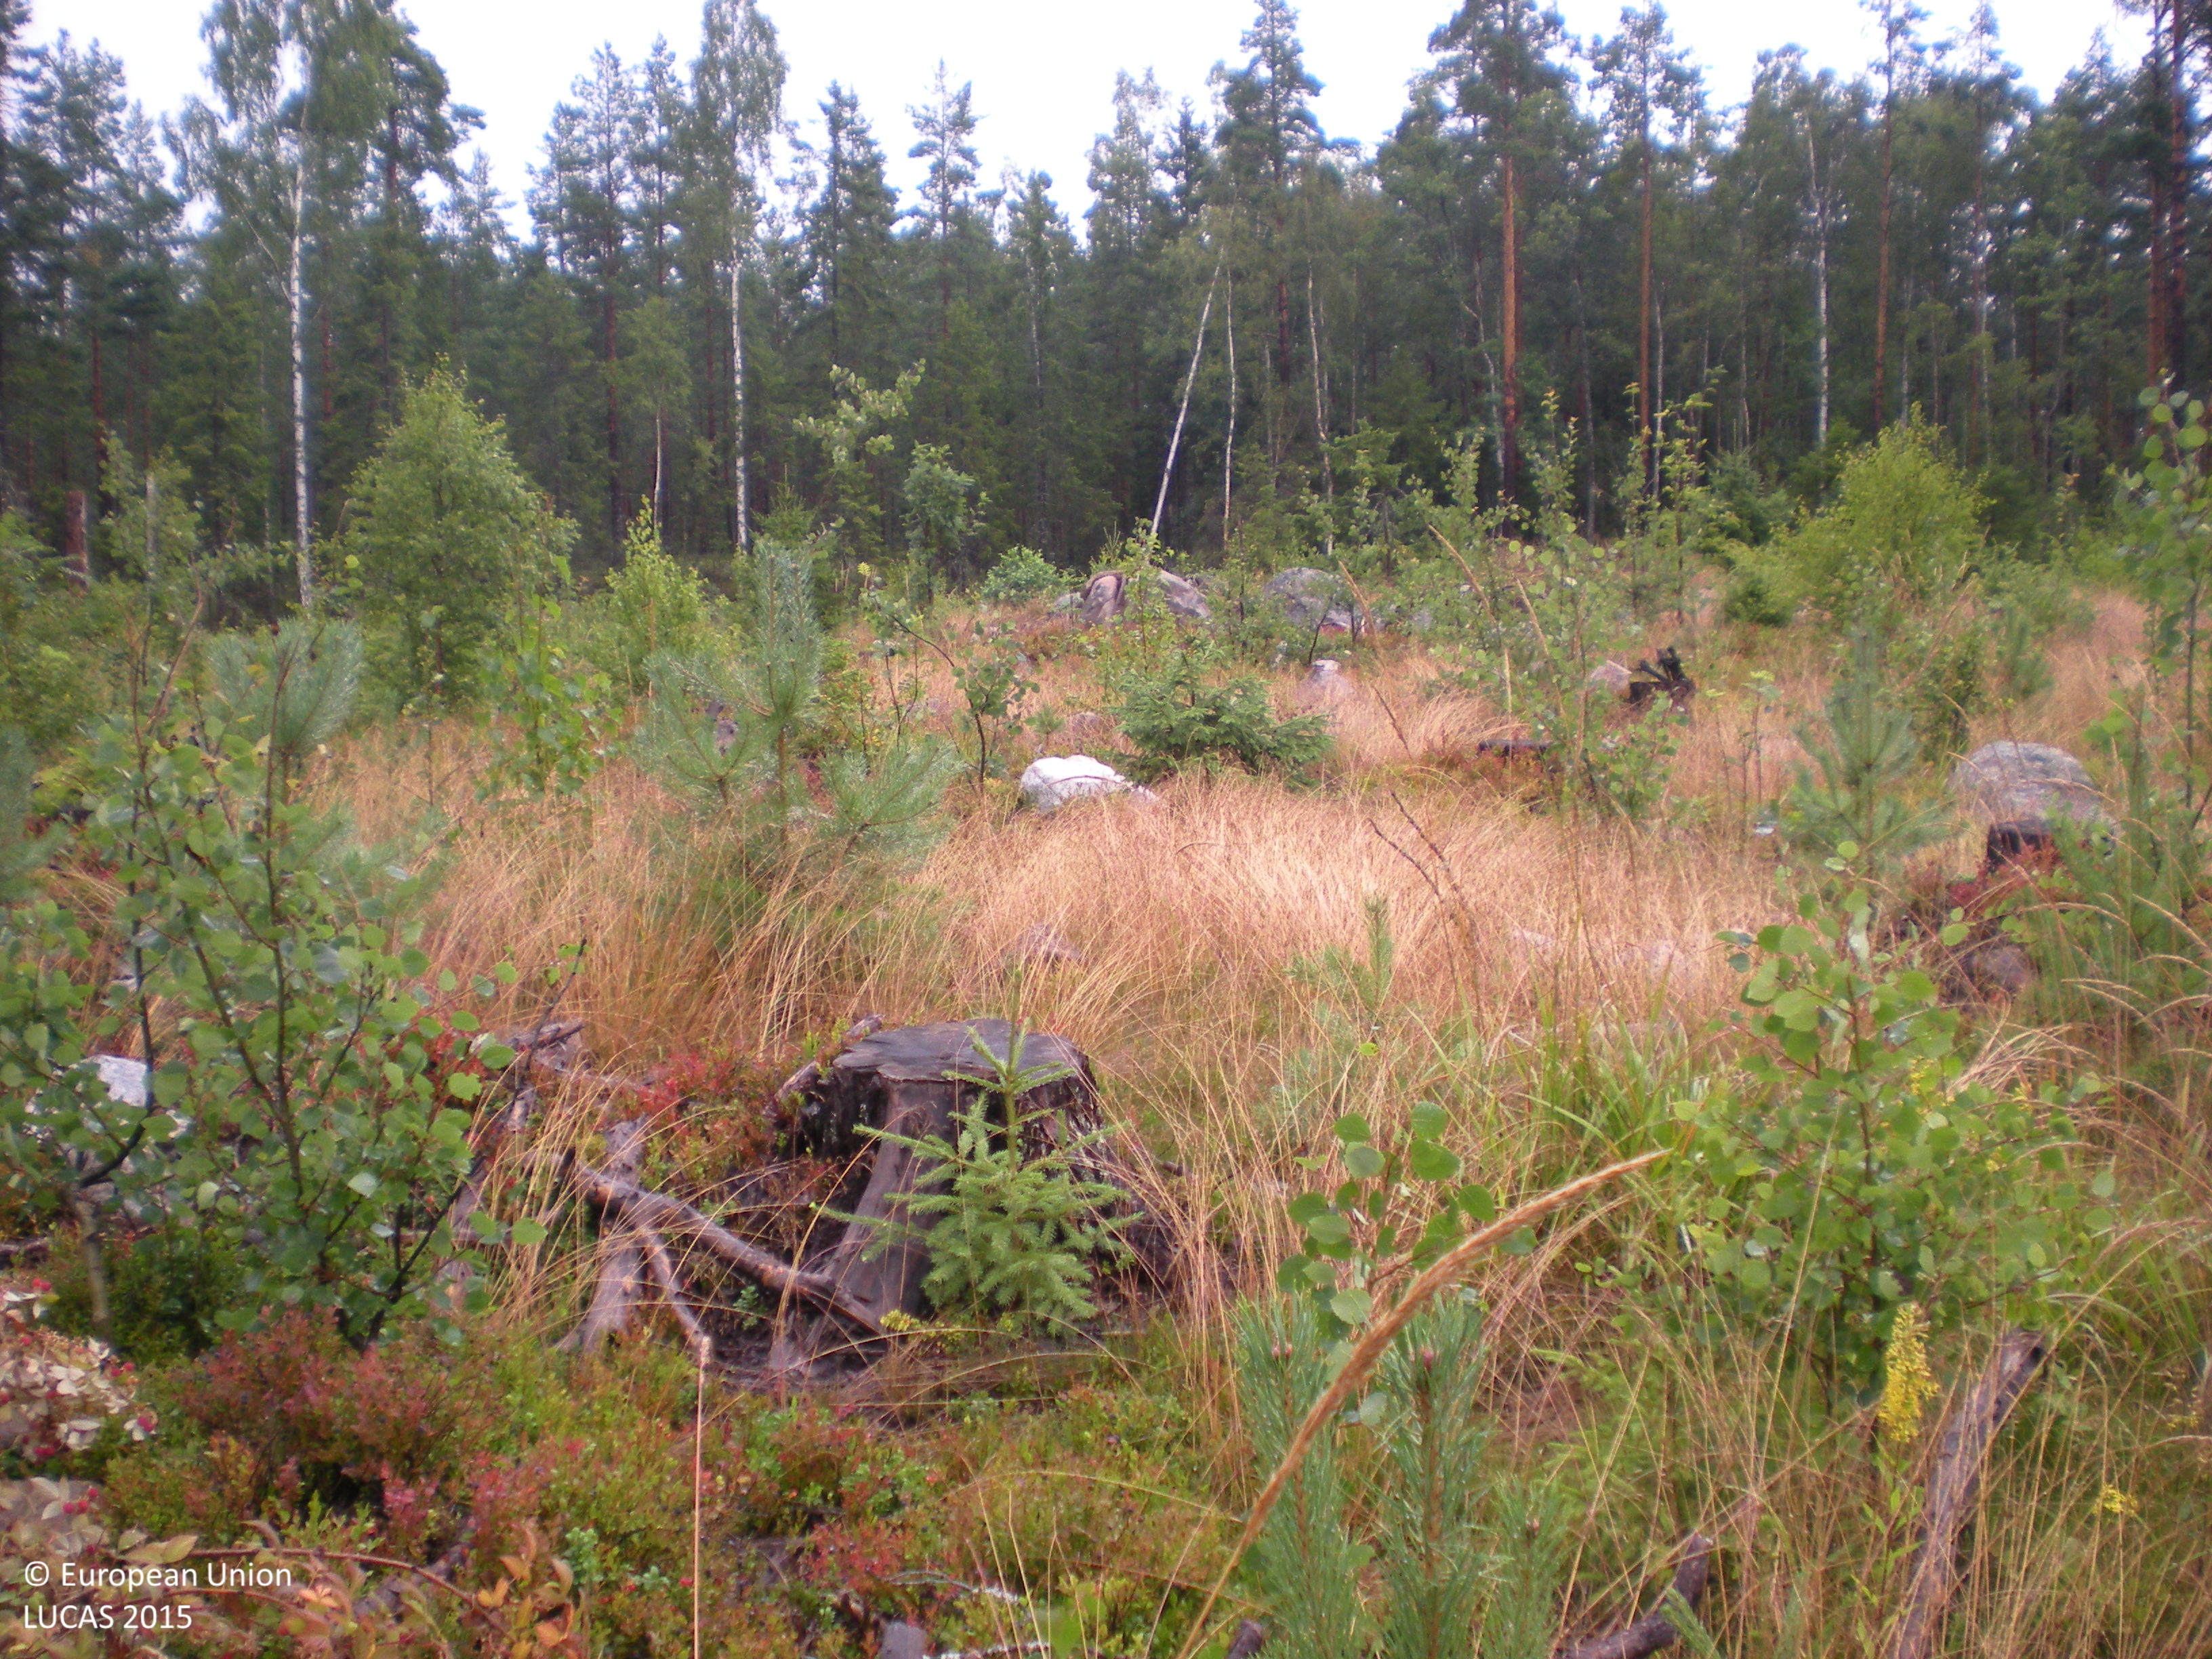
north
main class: Woodland
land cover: Pine dominated mixed woodland
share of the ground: 25 - 50 %
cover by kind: herbaceous plants 35 %, coniferous forest trees 20 %, shrubs 20 %, broadleaved forest trees 15 %, consolidated bare surface 5 %
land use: Forestry
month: August
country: SE
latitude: 60.7509
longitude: 17.3097
